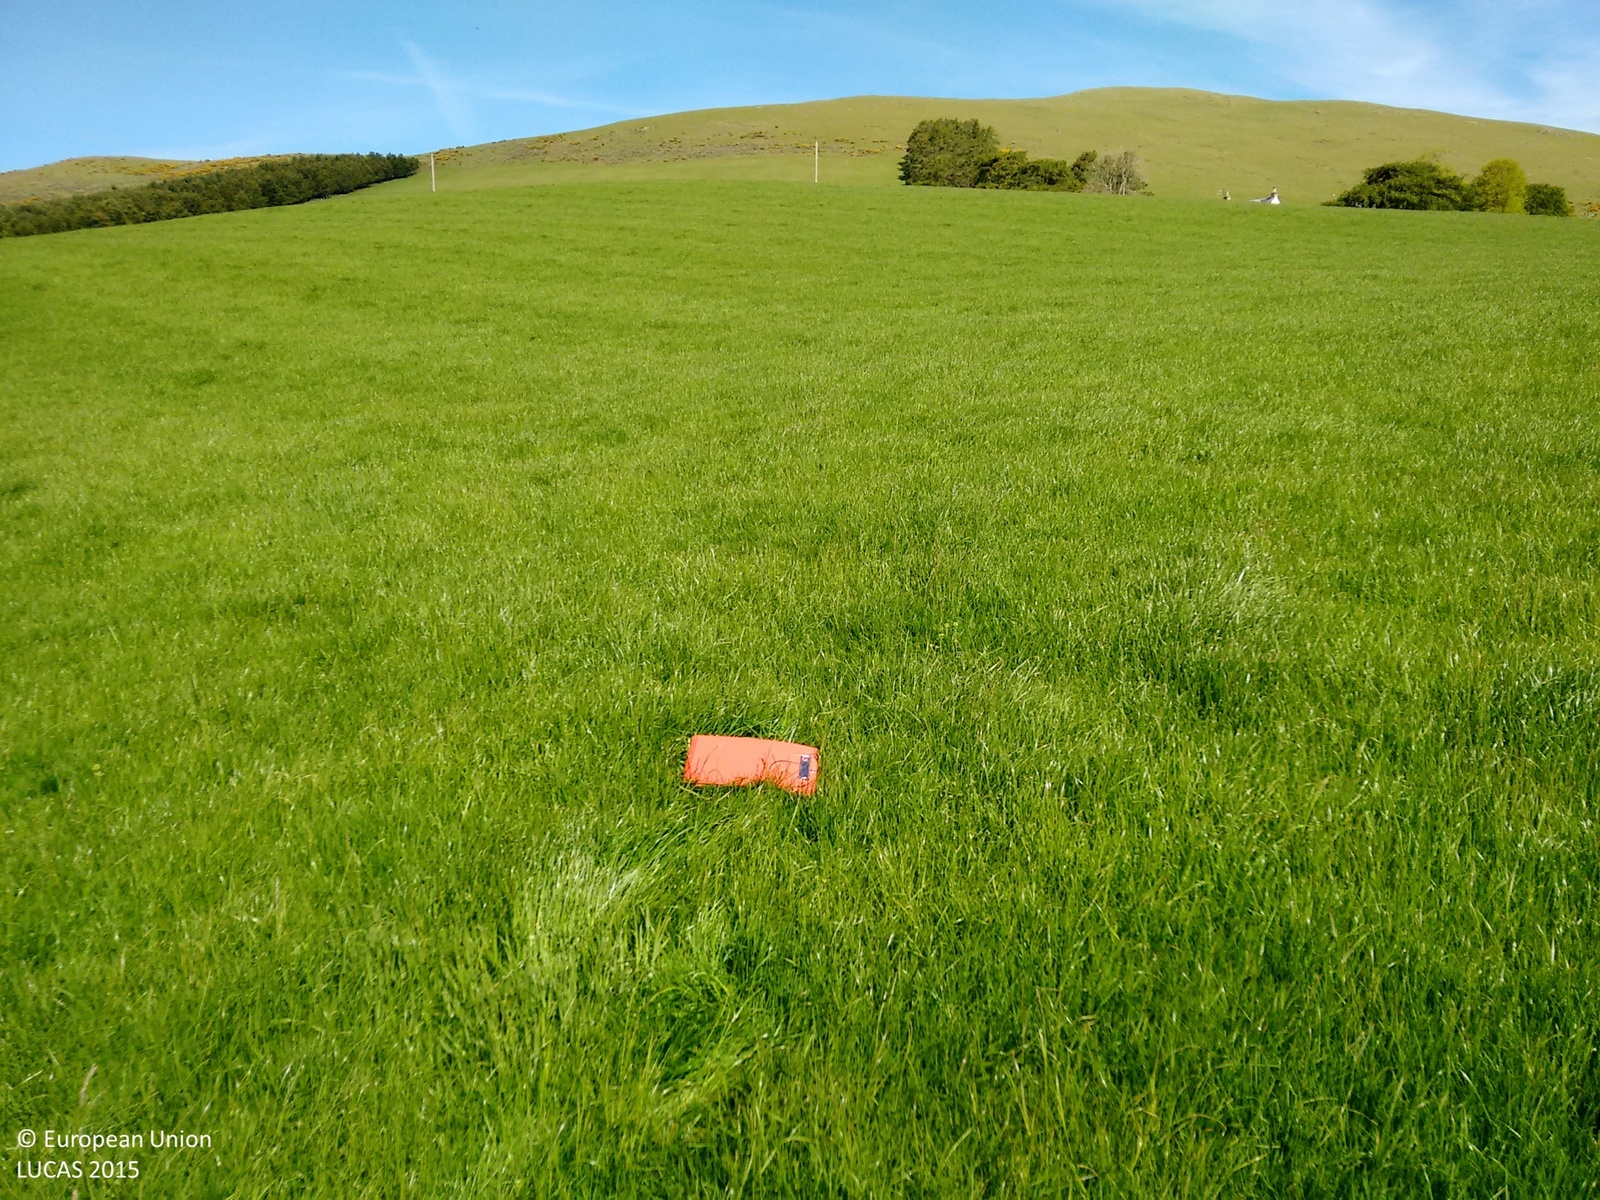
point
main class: Grassland
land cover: Grassland without tree/shrub cover
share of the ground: > 75 %
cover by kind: herbaceous plants 100 %
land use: Agriculture (excluding fallow land and kitchen gardens)
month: June
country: GB
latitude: 55.5989
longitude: -3.4891
